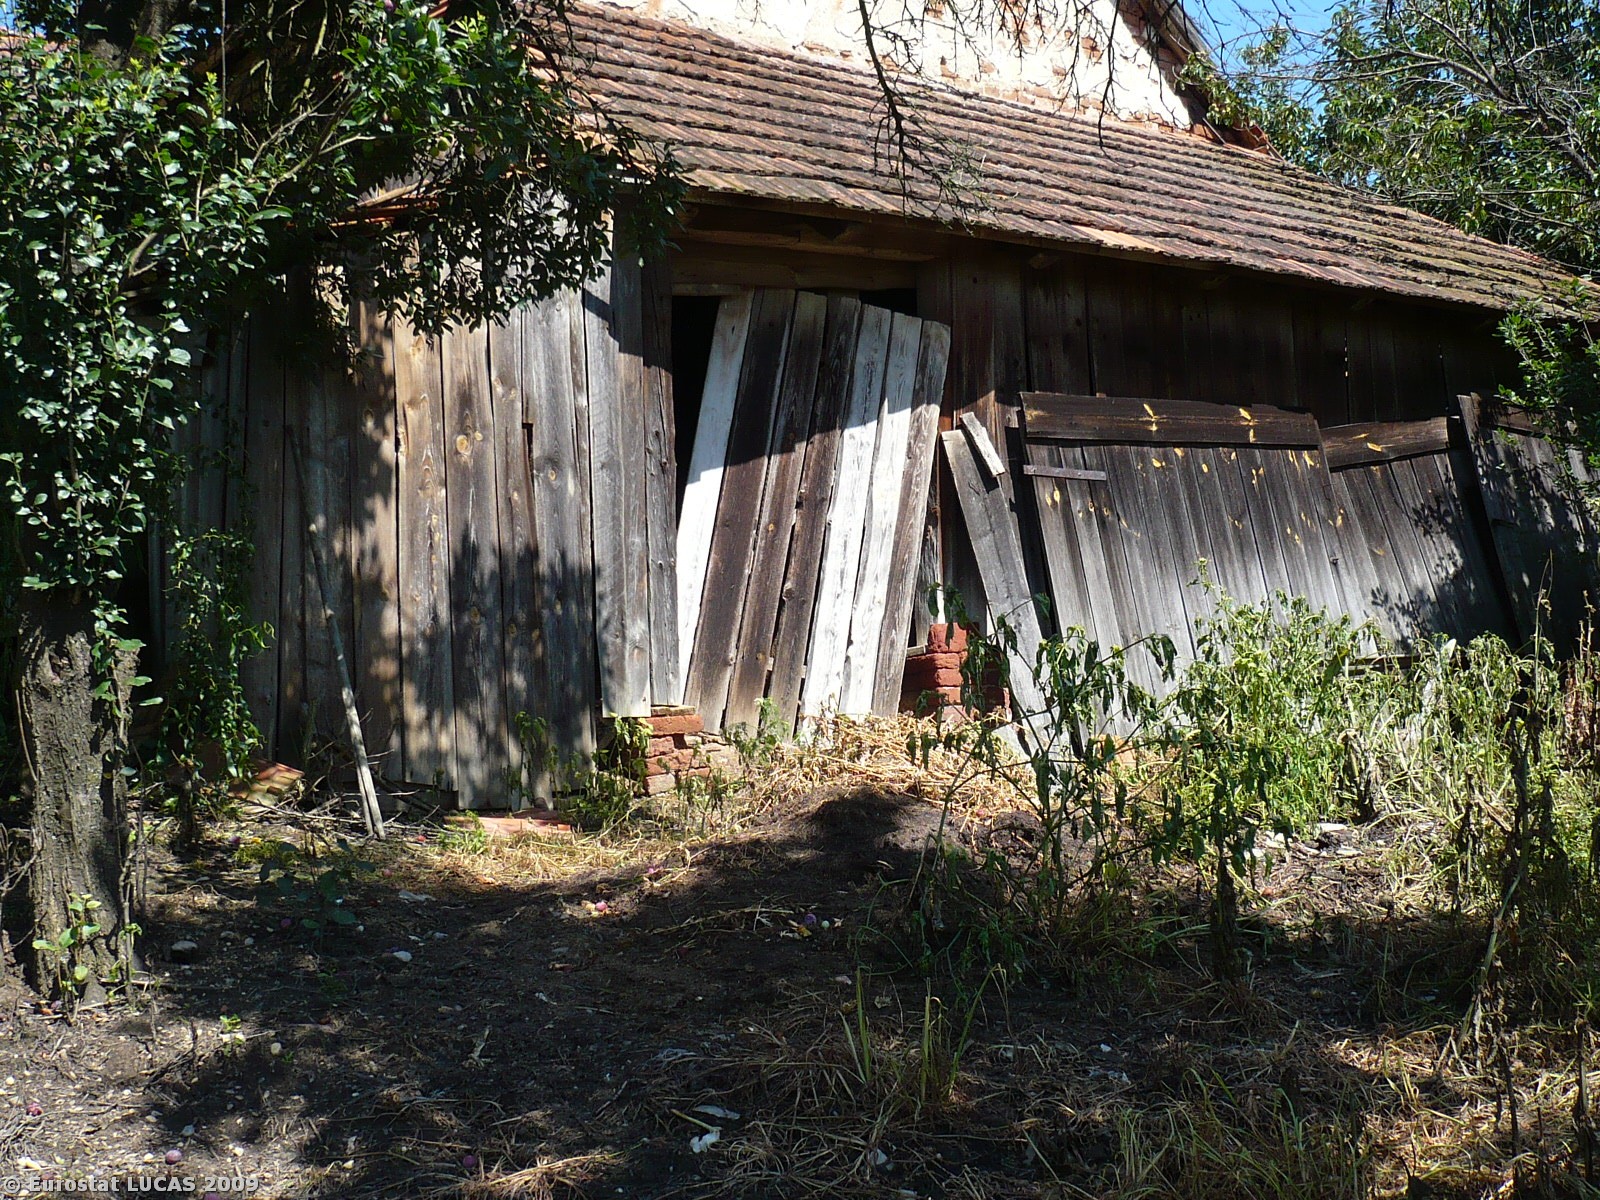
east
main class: Grassland
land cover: Grassland with sparse tree/shrub cover
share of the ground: 50 - 75 %
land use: Residential
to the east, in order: Grassland with sparse tree/shrub cover; Artificial constructions in urban areas; Tracks; Grassland without tree/shrub cover; Paved roads, cycling and walking lanes; Grass margins; Broadleaved woodland; Ditches and canals; Broadleaved woodland
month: July
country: SI
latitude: 46.8439
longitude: 16.1248
